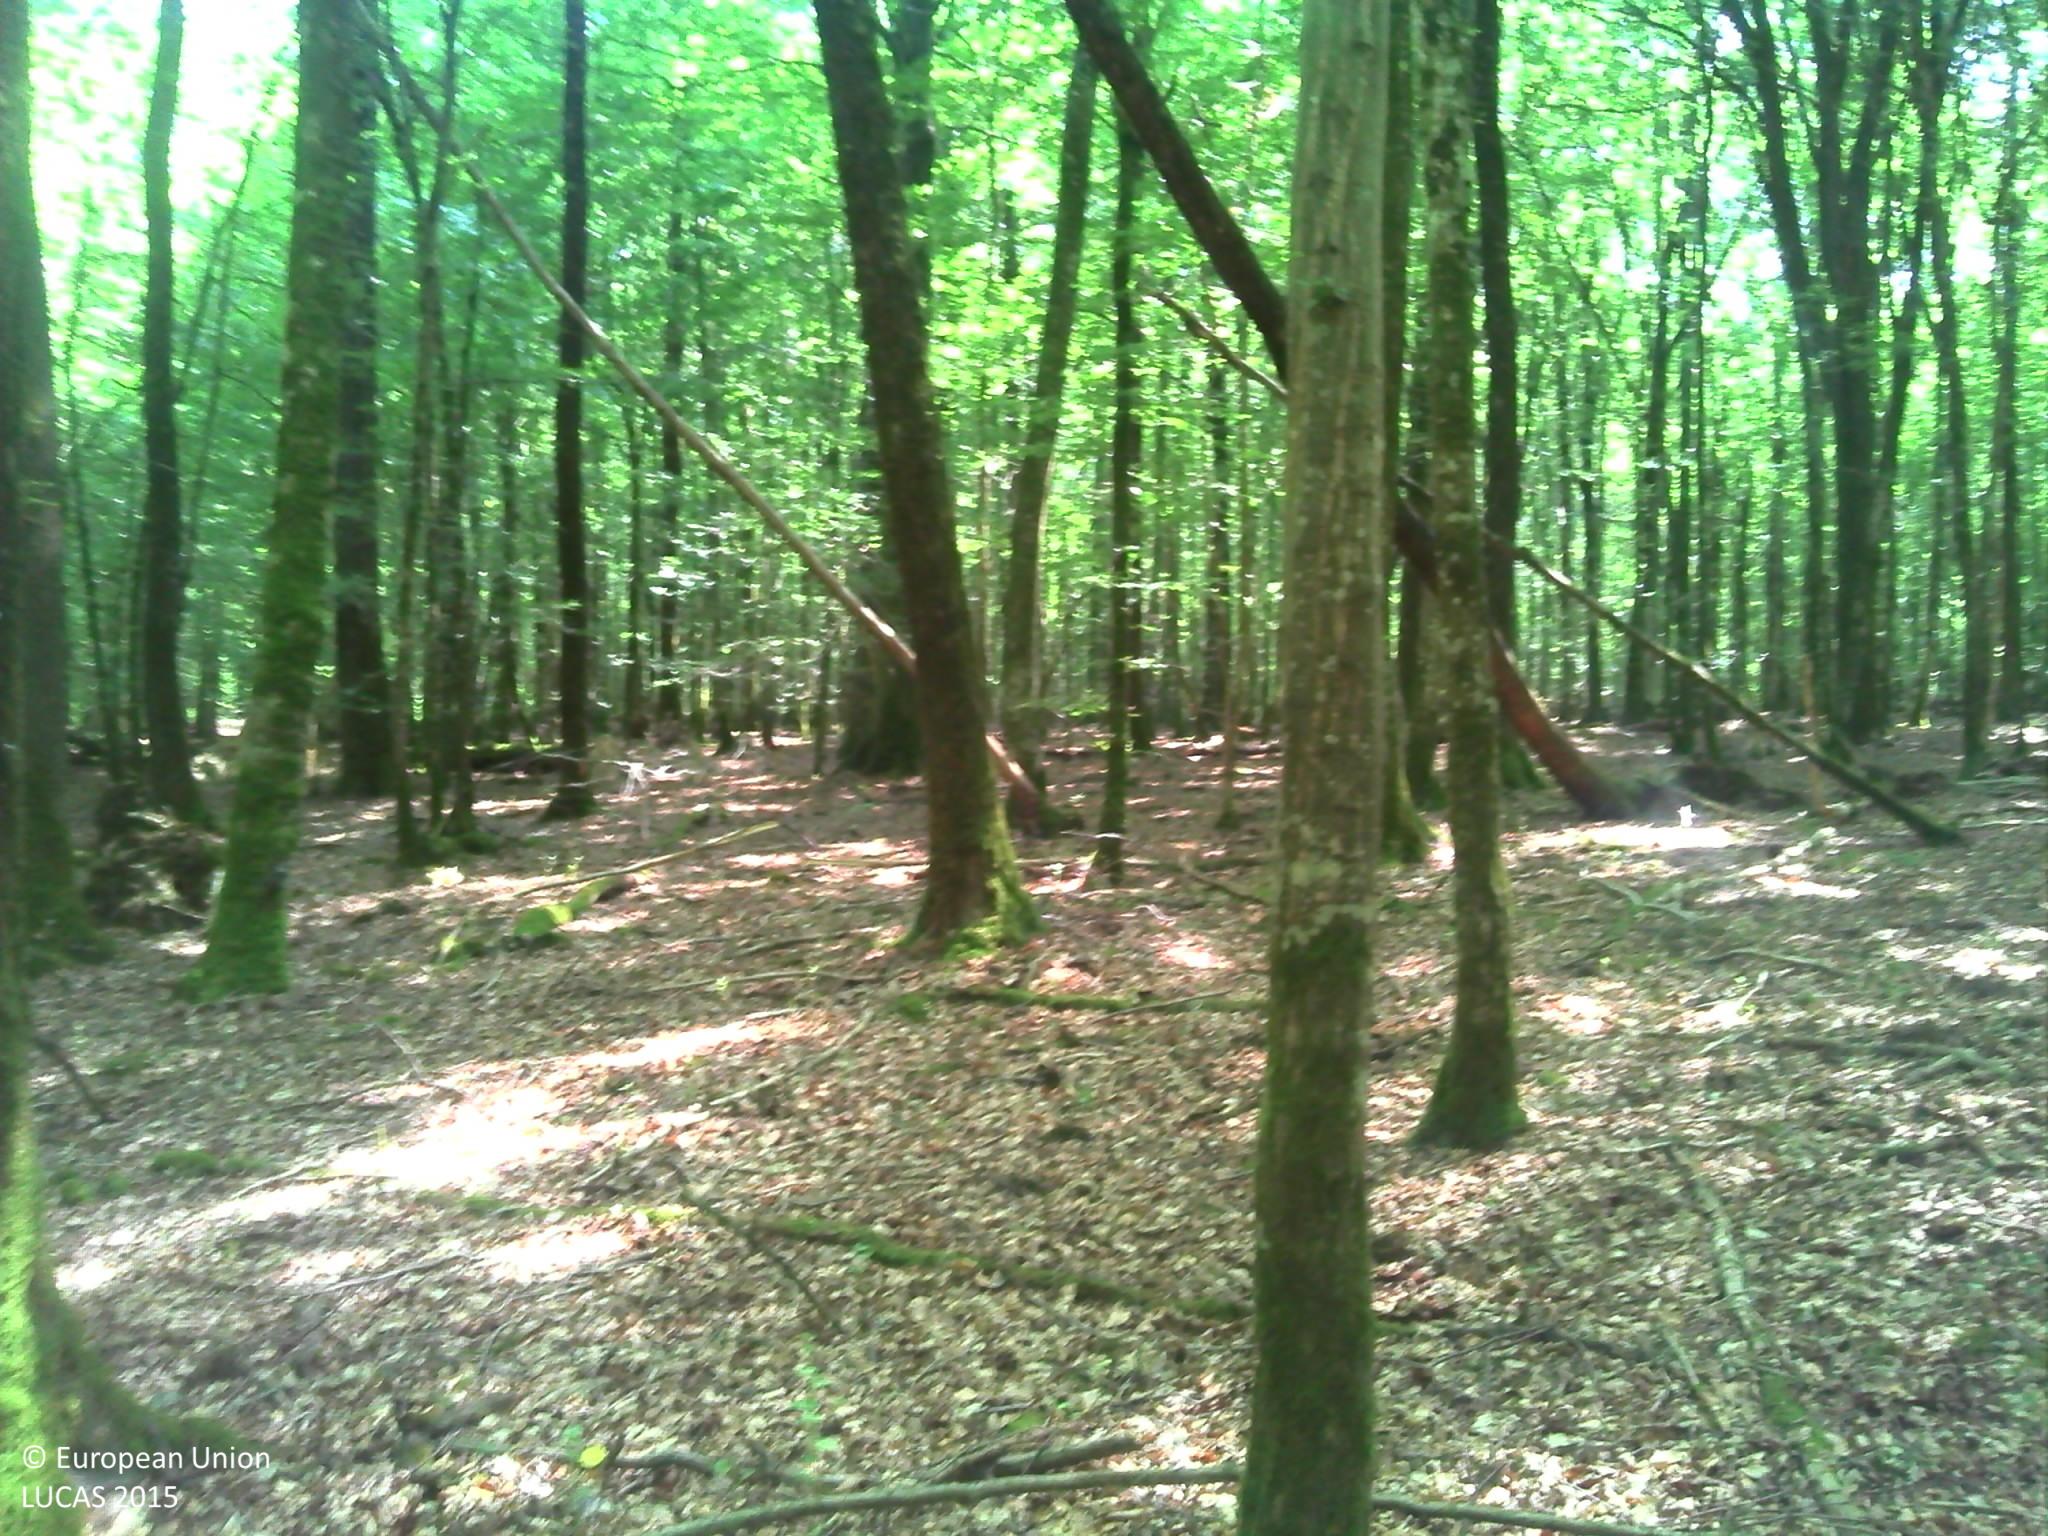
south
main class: Woodland
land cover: Broadleaved woodland
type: acidophilous oak and oak-birch forest
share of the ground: > 75 %
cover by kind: broadleaved forest trees 90 %, herbaceous plants 5 %, lichens and mosses 5 %
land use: Forestry
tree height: > 5 m
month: July
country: FR
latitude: 48.1147
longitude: 0.8588
